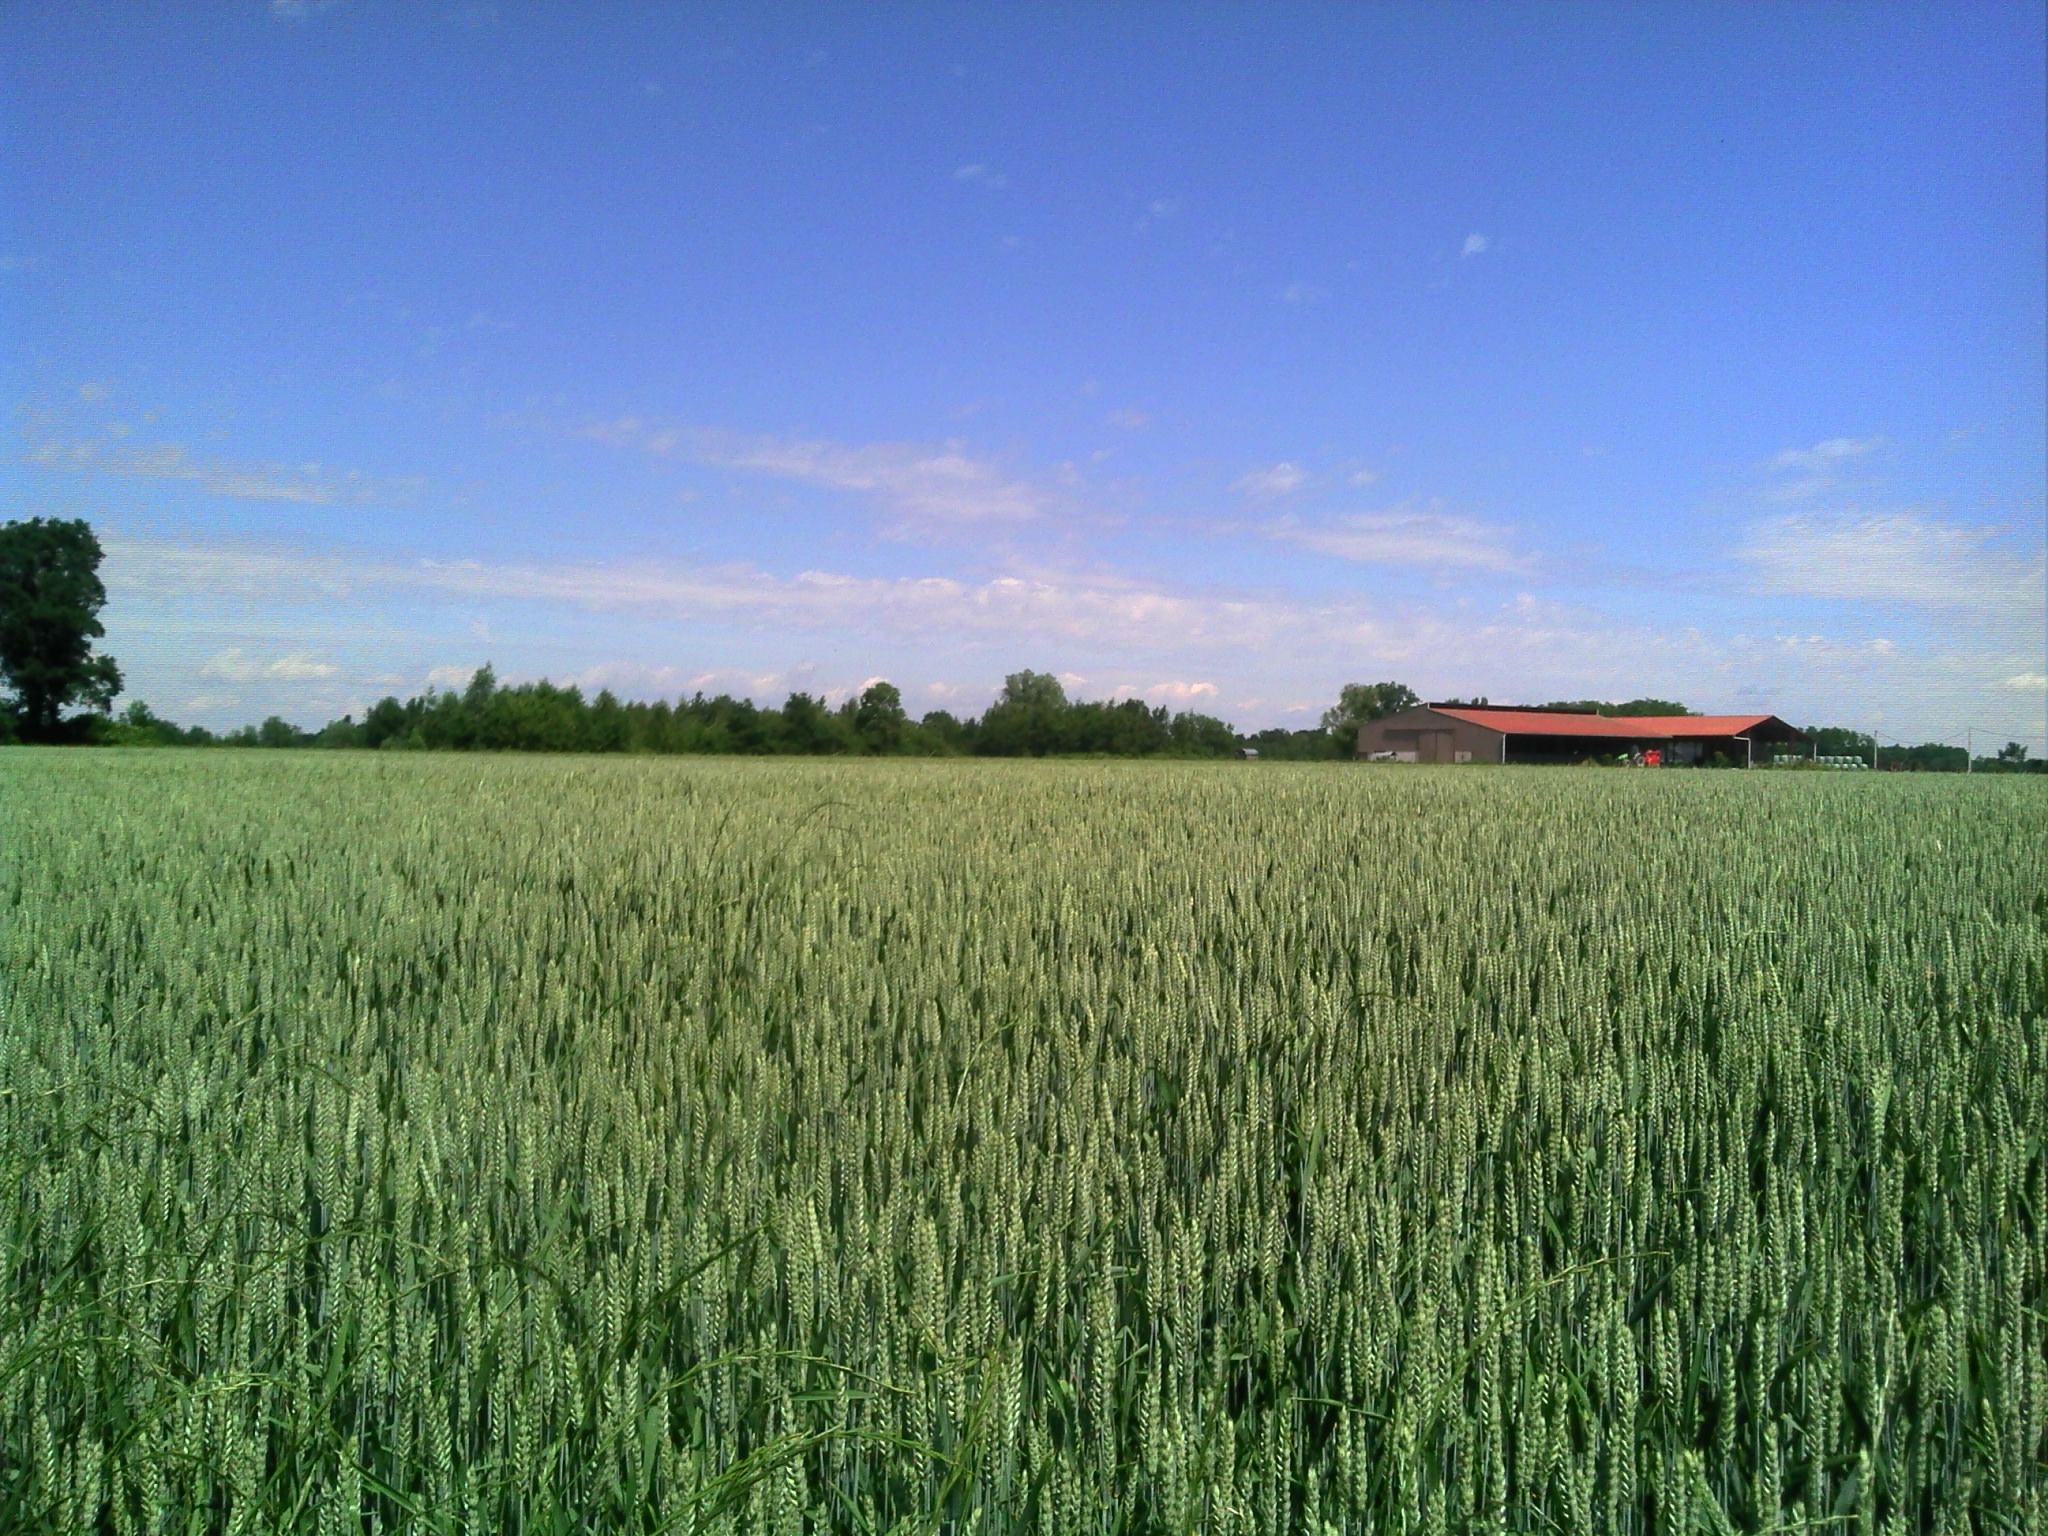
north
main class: Cropland
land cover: Common wheat
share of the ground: > 75 %
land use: Agriculture (excluding fallow land and kitchen gardens)
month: May
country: FR
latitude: 46.5761
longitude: 4.9783
